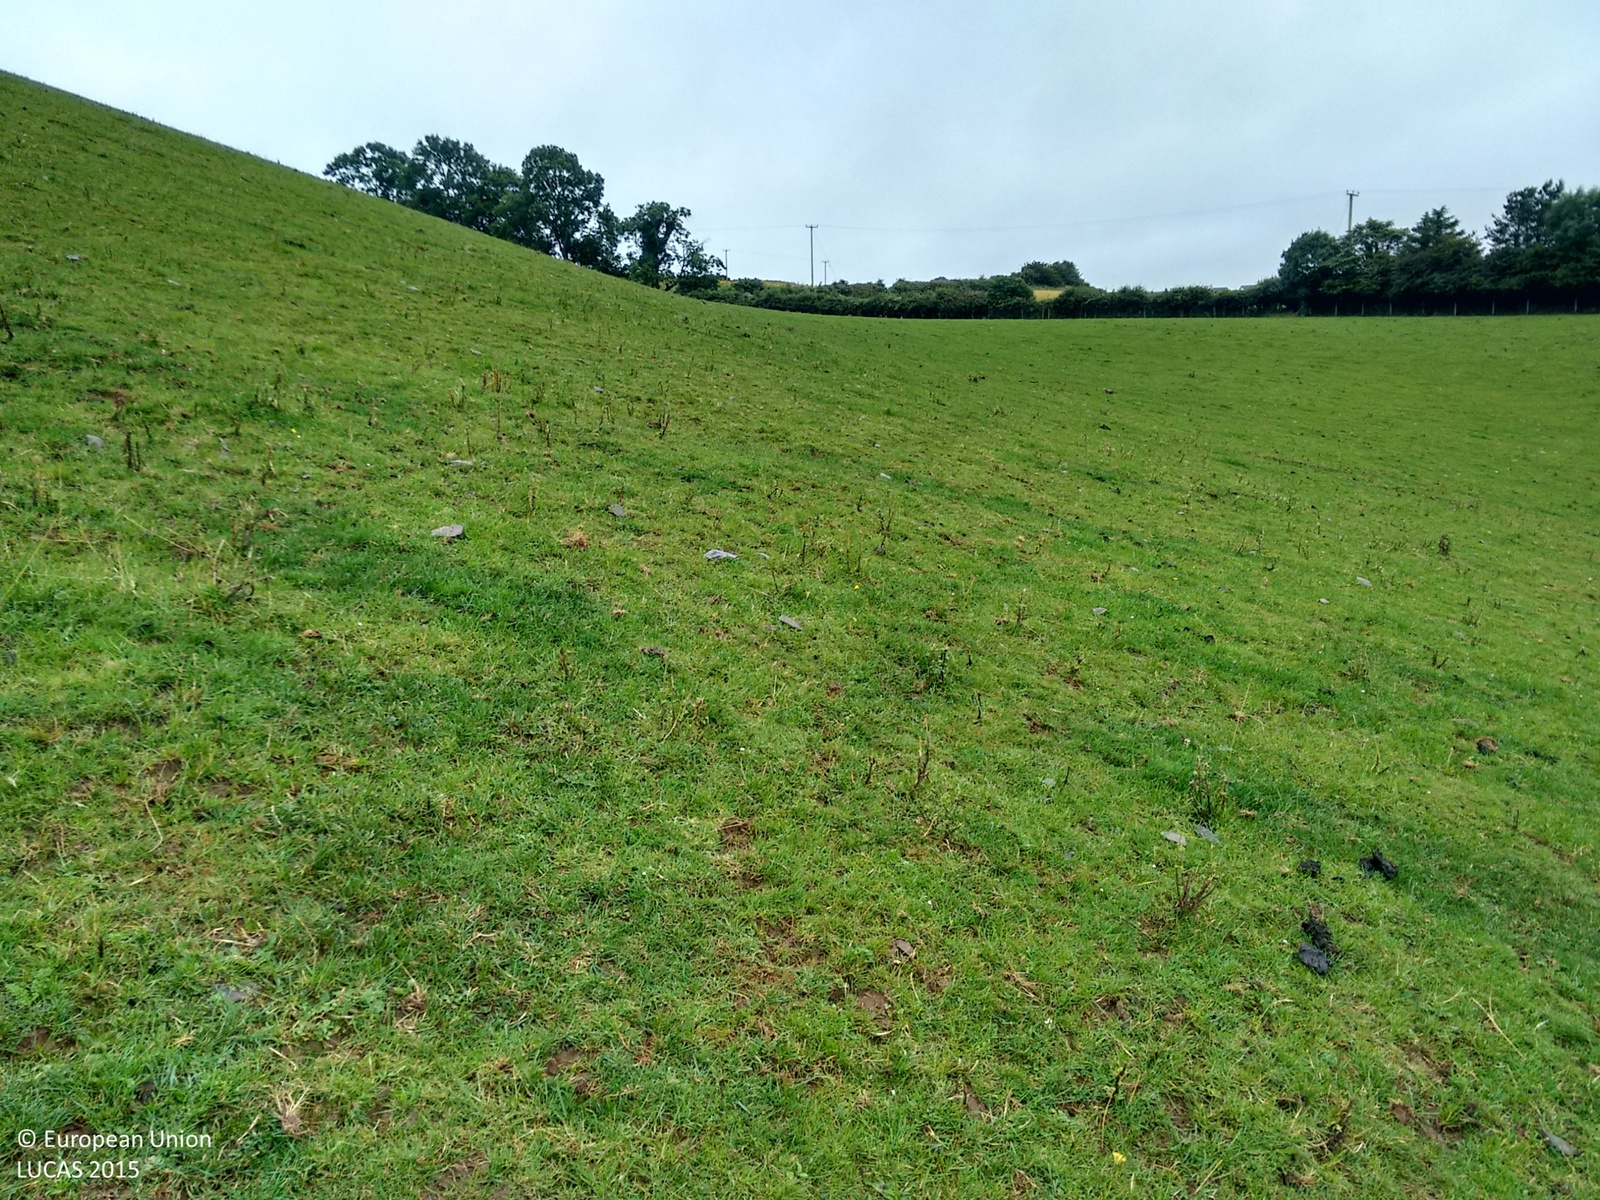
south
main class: Grassland
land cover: Grassland without tree/shrub cover
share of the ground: > 75 %
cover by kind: herbaceous plants 100 %
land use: Agriculture (excluding fallow land and kitchen gardens)
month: August
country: GB
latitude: 54.3590
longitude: -5.6272
